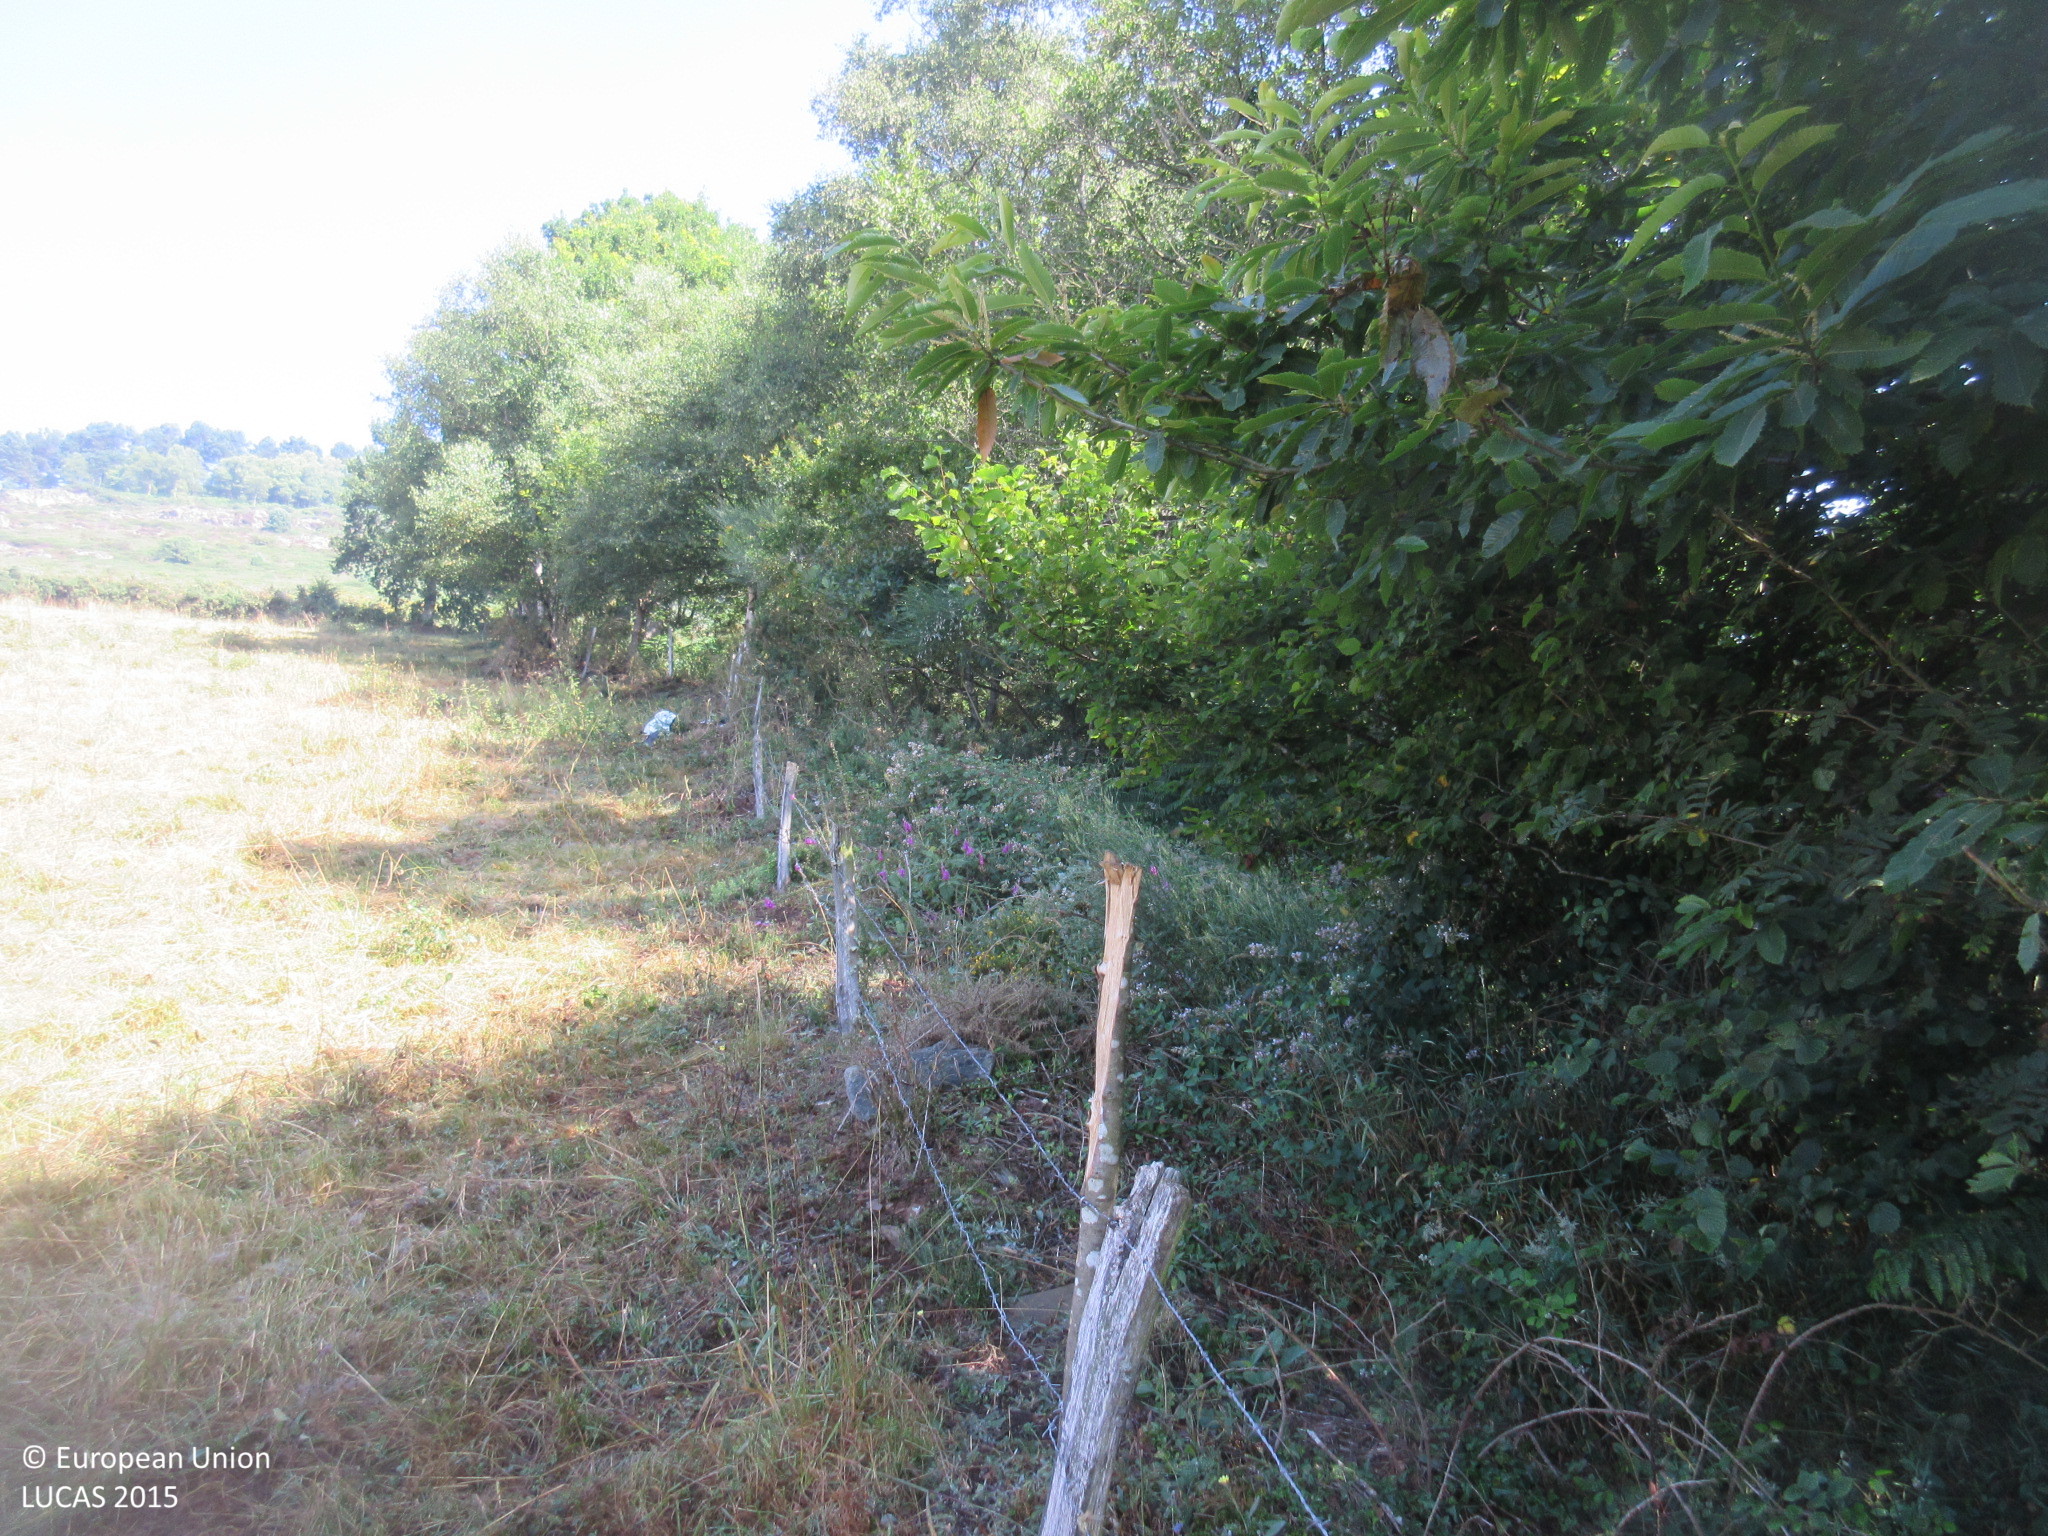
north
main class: Woodland
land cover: Broadleaved woodland
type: thermophilous deciduous forest
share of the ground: > 75 %
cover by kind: broadleaved forest trees 95 %, shrubs 5 %
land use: Forestry
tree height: > 5 m
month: July
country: ES
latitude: 43.3694
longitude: -6.3778
